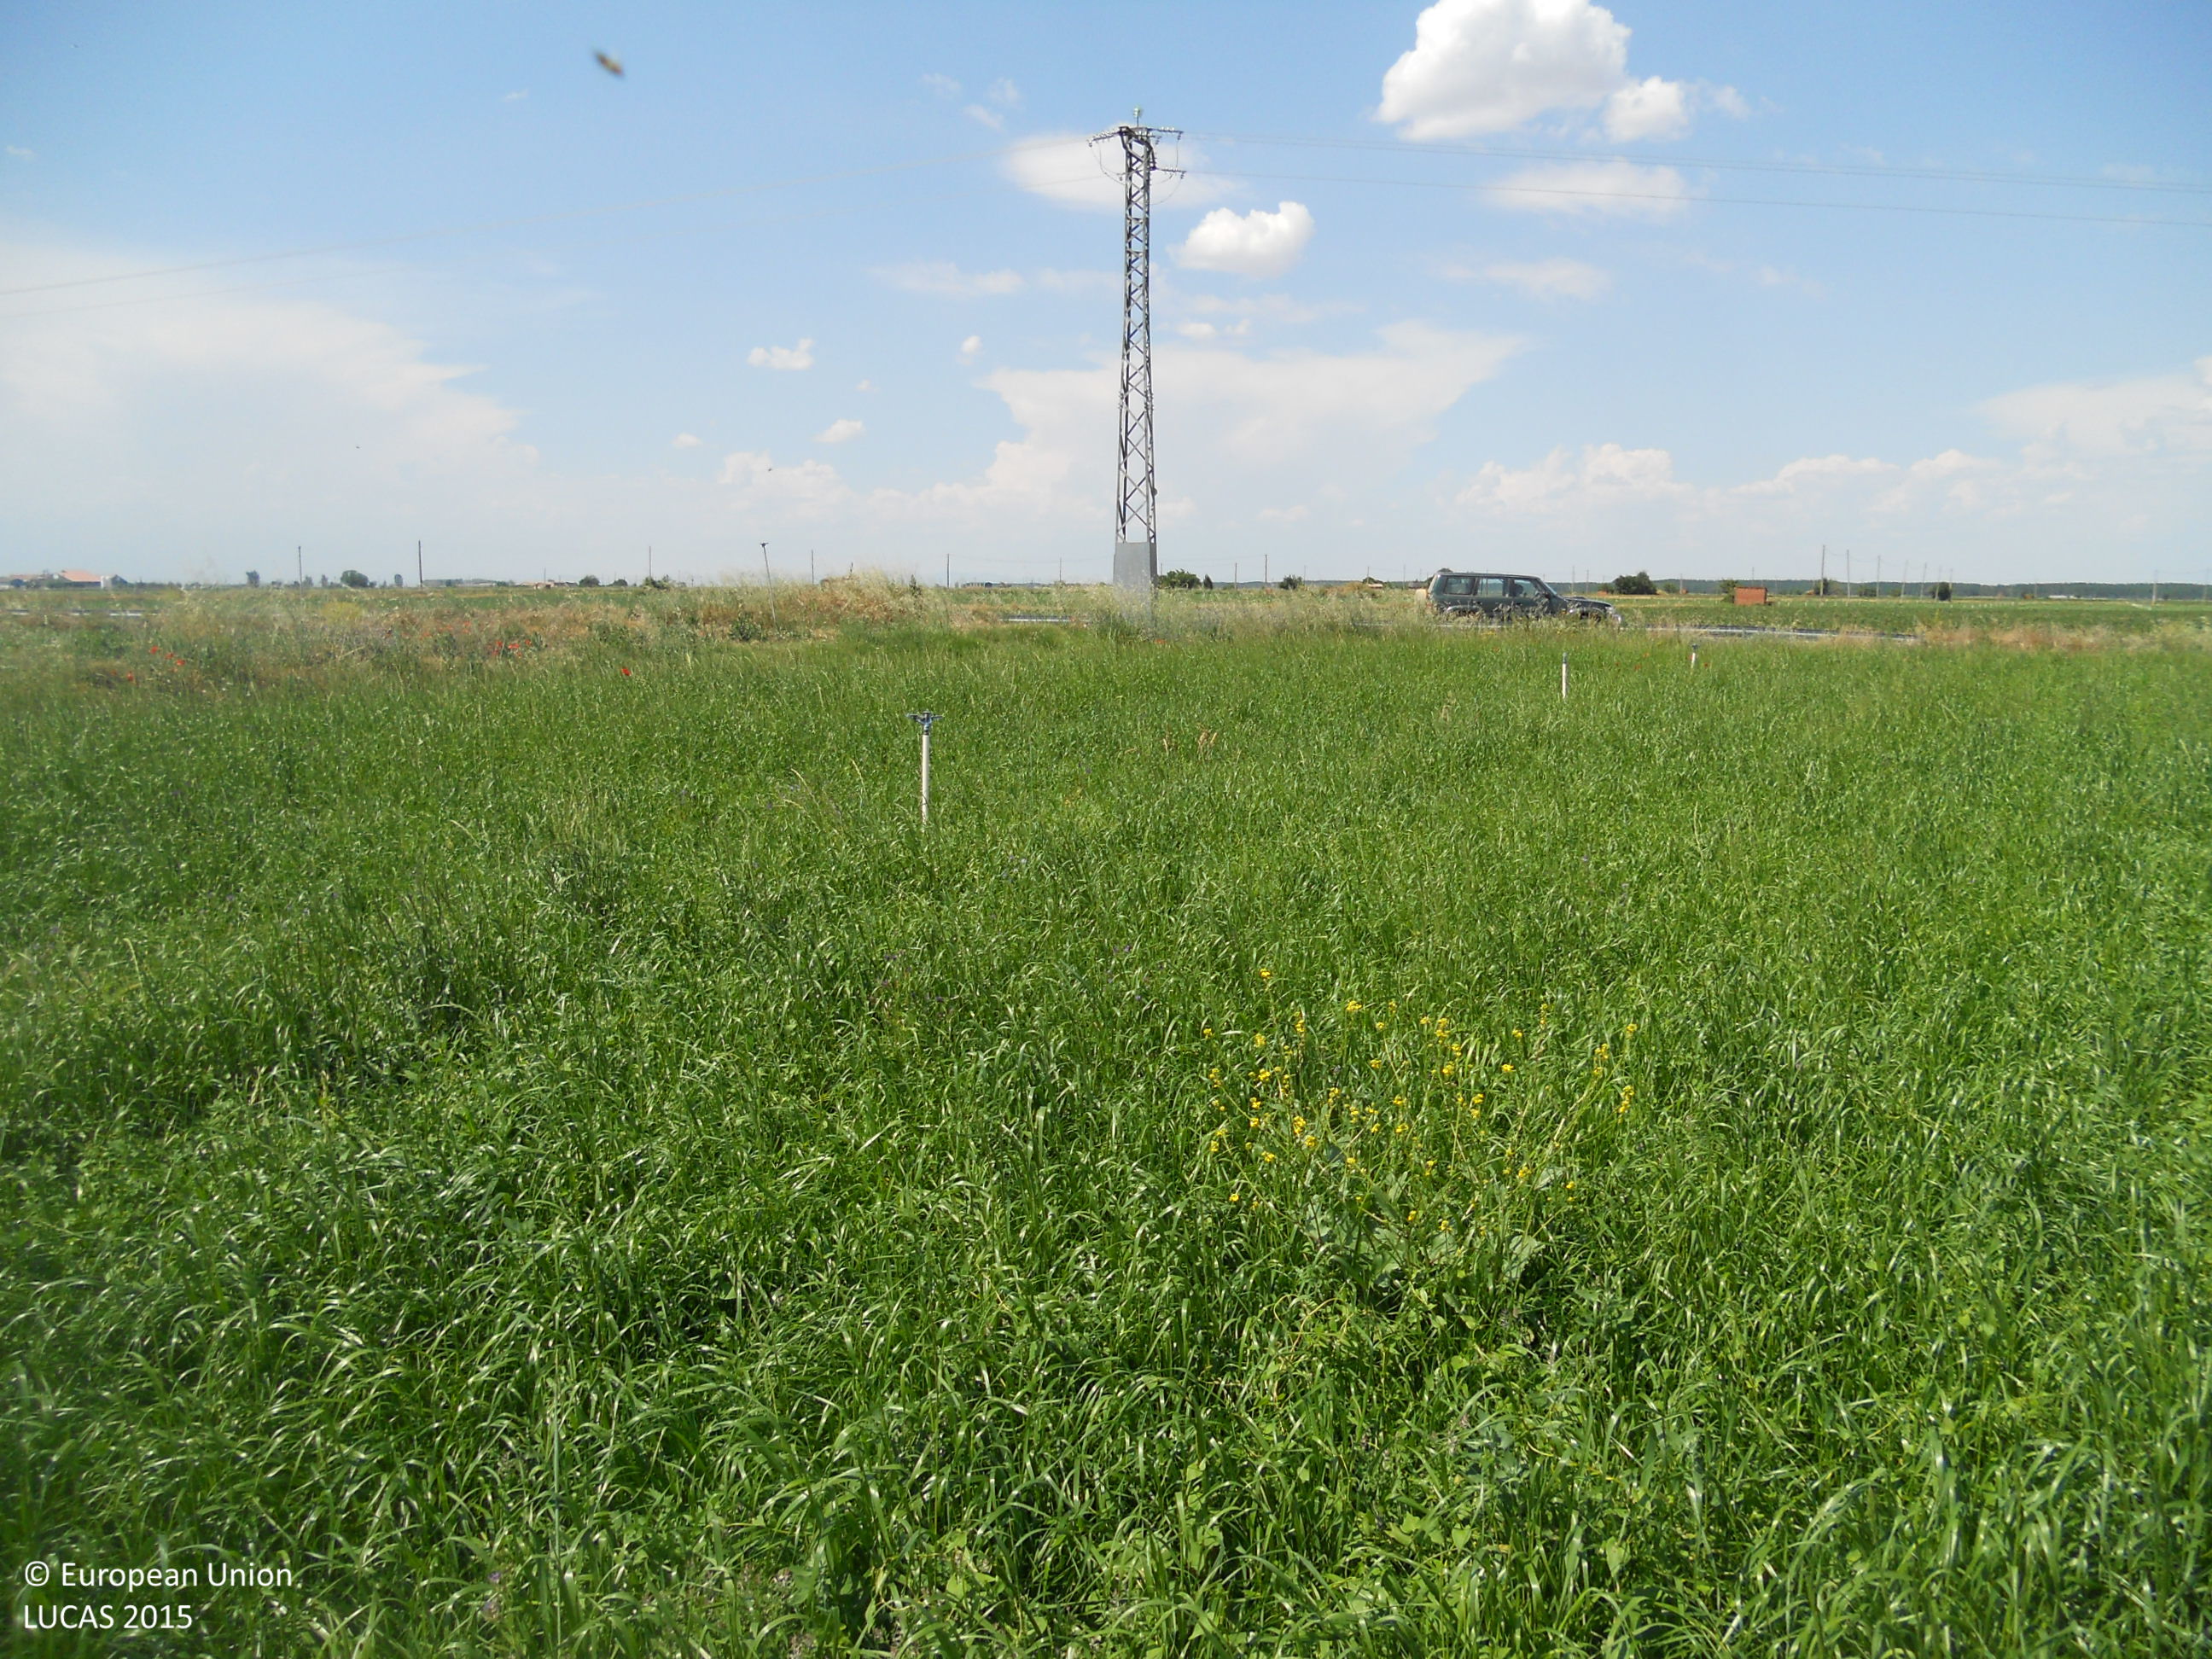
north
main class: Cropland
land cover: Temporary grasslands
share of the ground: > 75 %
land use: Agriculture (excluding fallow land and kitchen gardens)
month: June
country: ES
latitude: 42.2379
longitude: -5.6415
